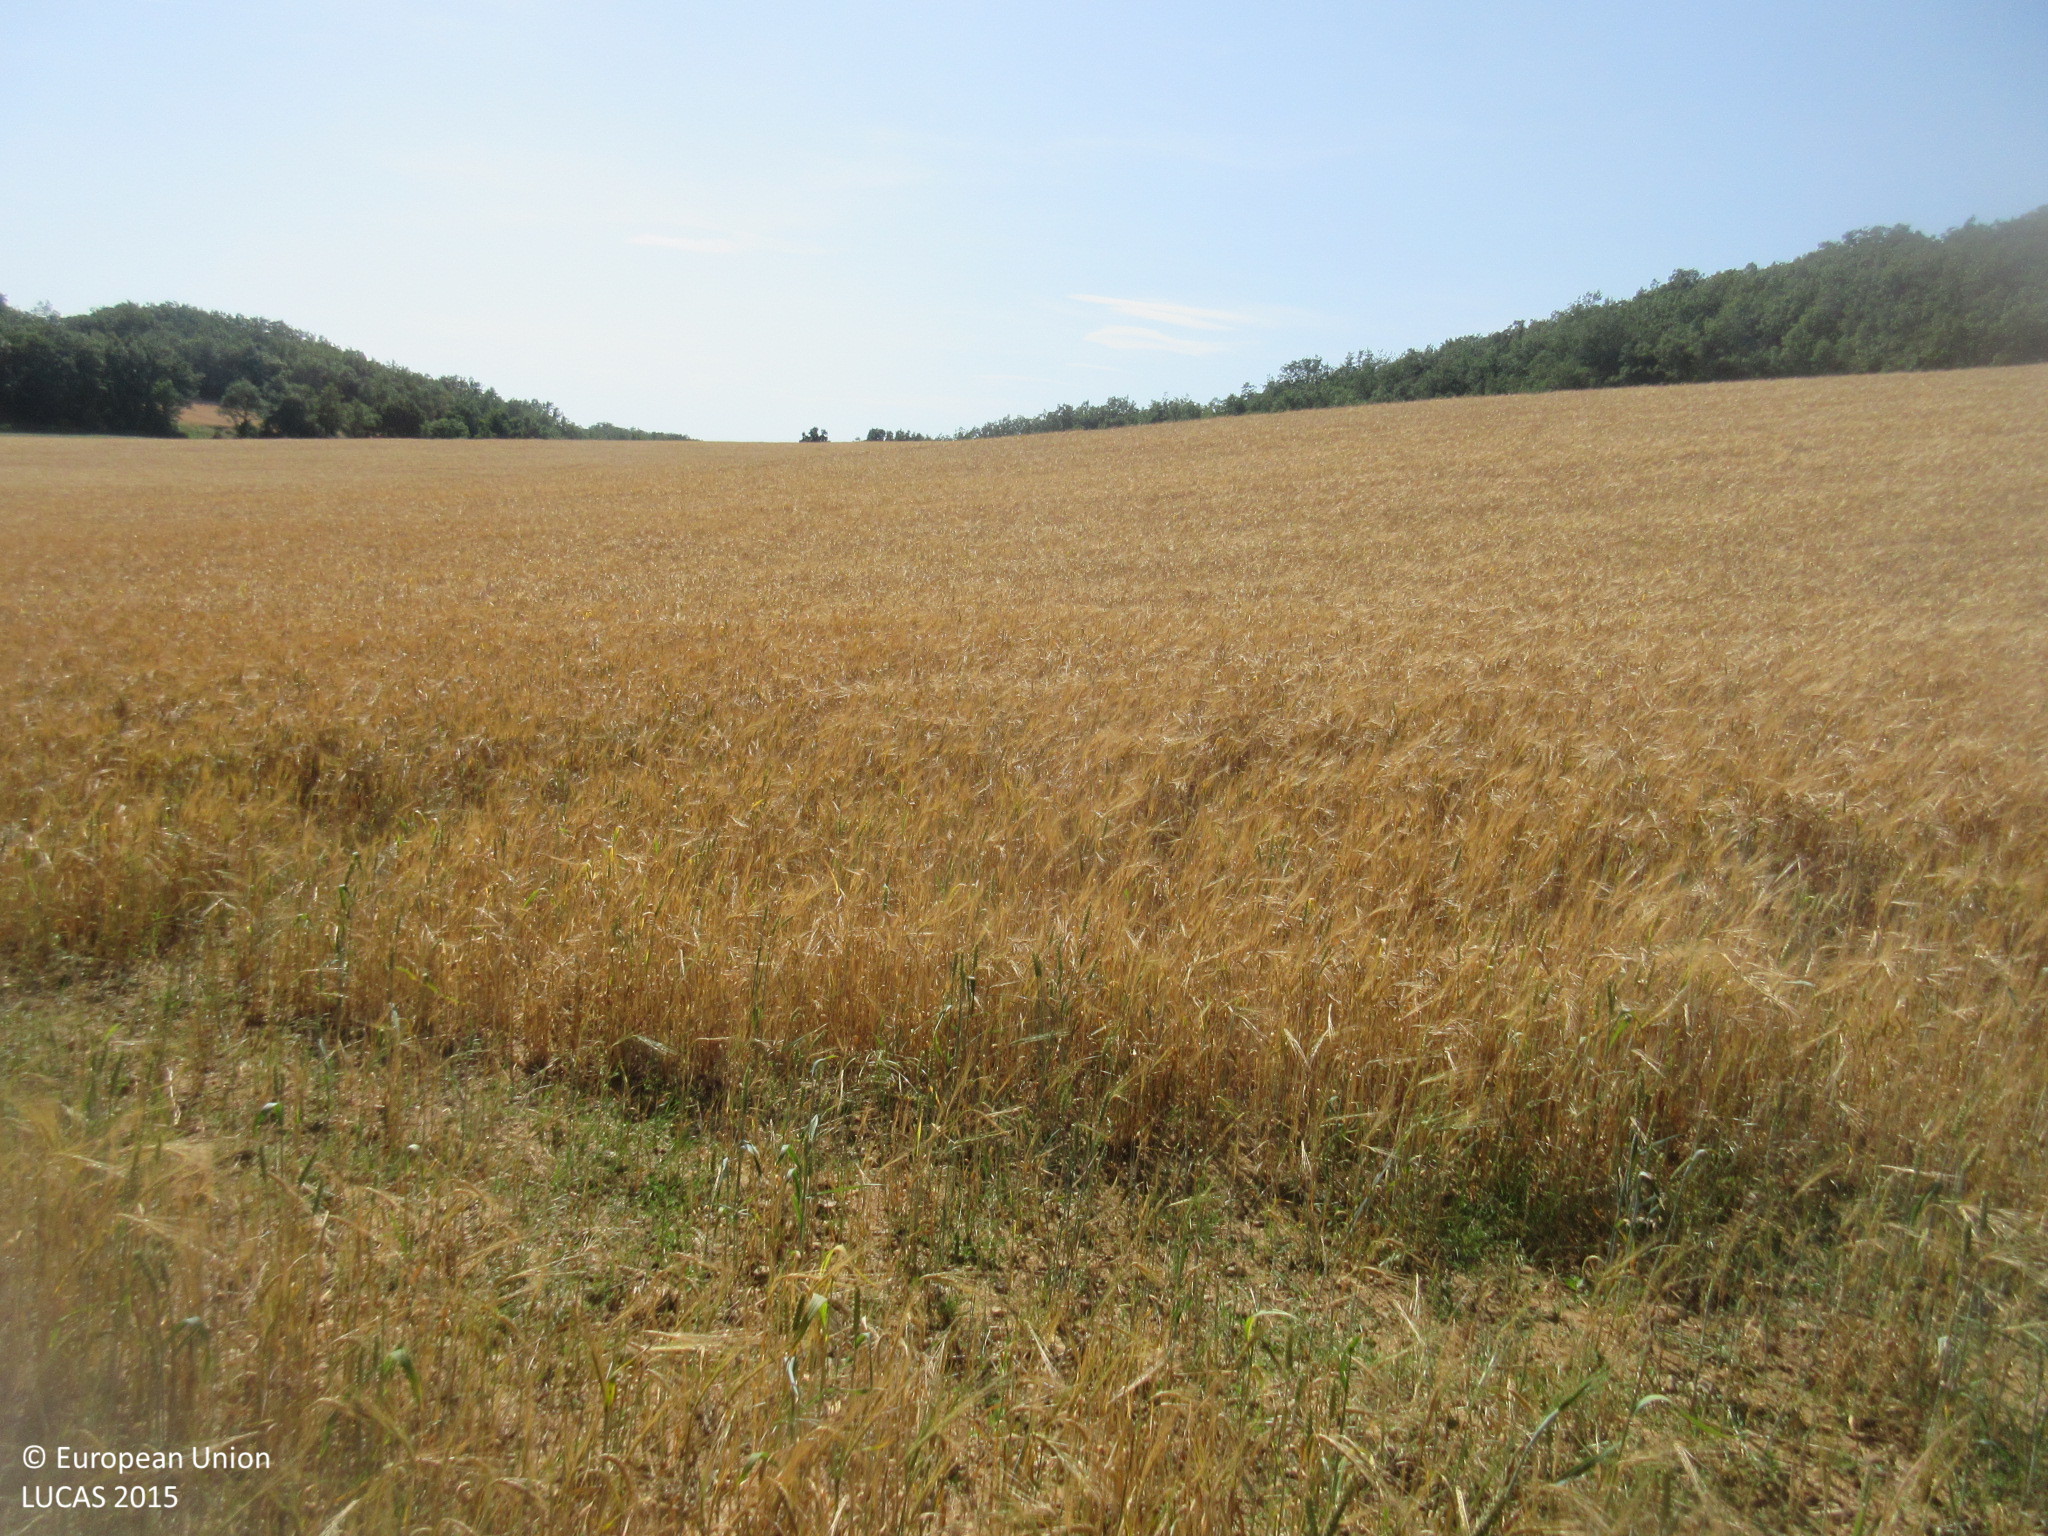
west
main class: Woodland
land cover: Broadleaved woodland
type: acidophilous oak and oak-birch forest
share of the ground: > 75 %
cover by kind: broadleaved forest trees 100 %
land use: Semi-natural and natural areas not in use
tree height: > 5 m
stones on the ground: < 10 %
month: July
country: ES
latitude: 42.9991
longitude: -3.4215
